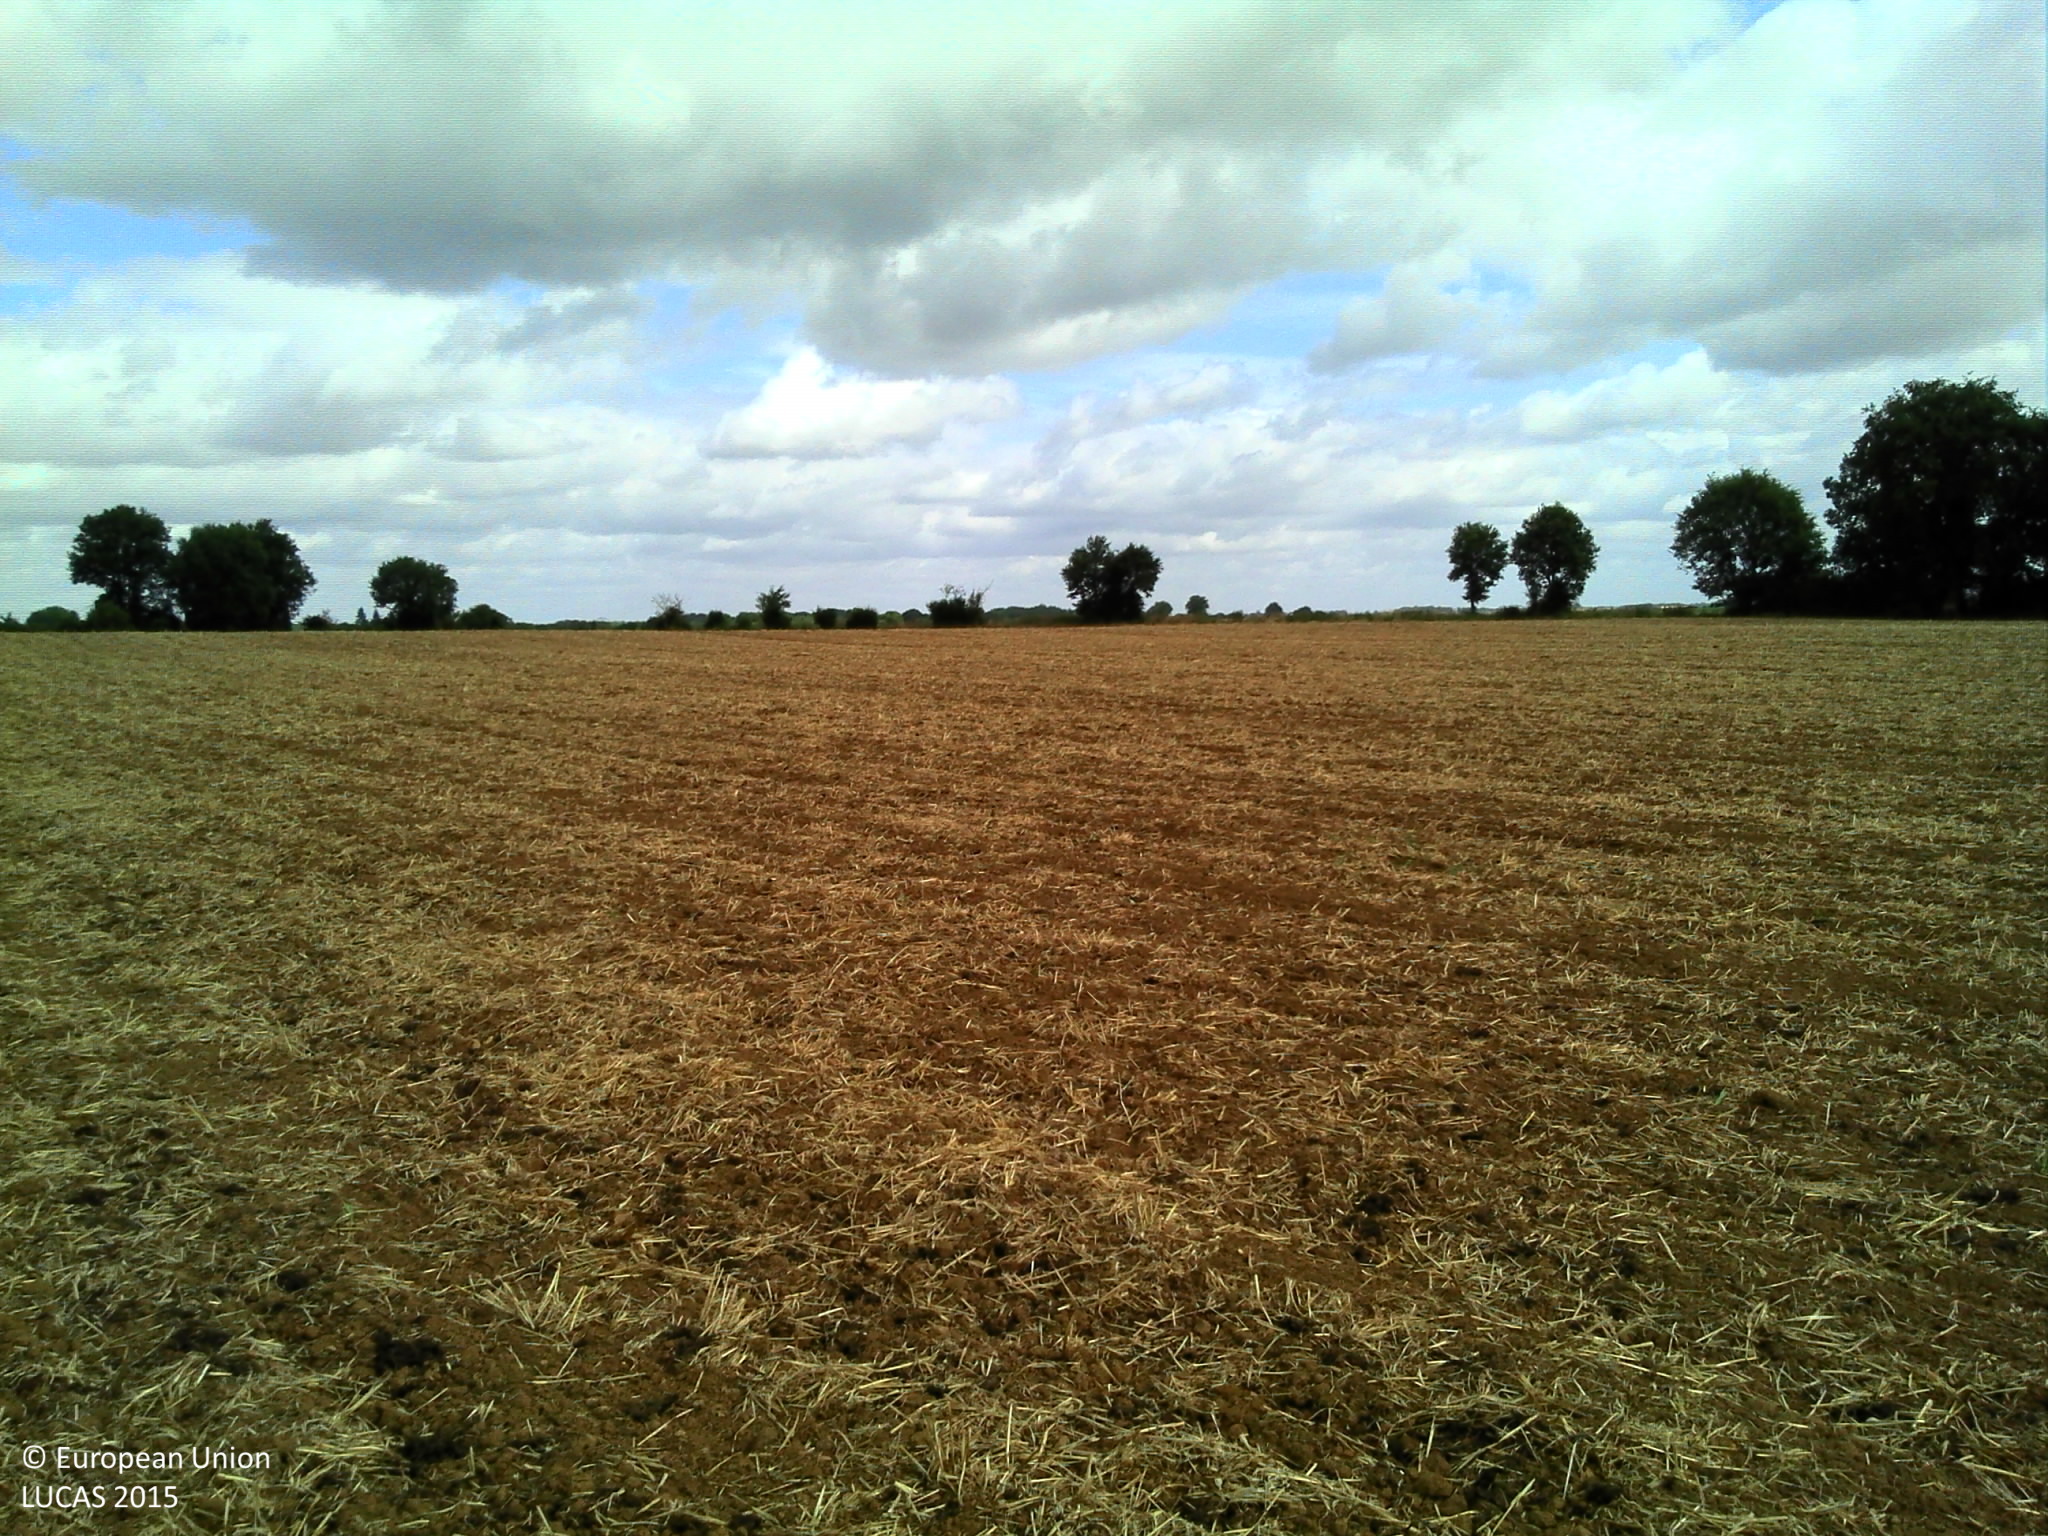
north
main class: Cropland
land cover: Barley
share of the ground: < 10 %
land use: Agriculture (excluding fallow land and kitchen gardens)
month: July
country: FR
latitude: 46.3912
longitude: 0.2144
